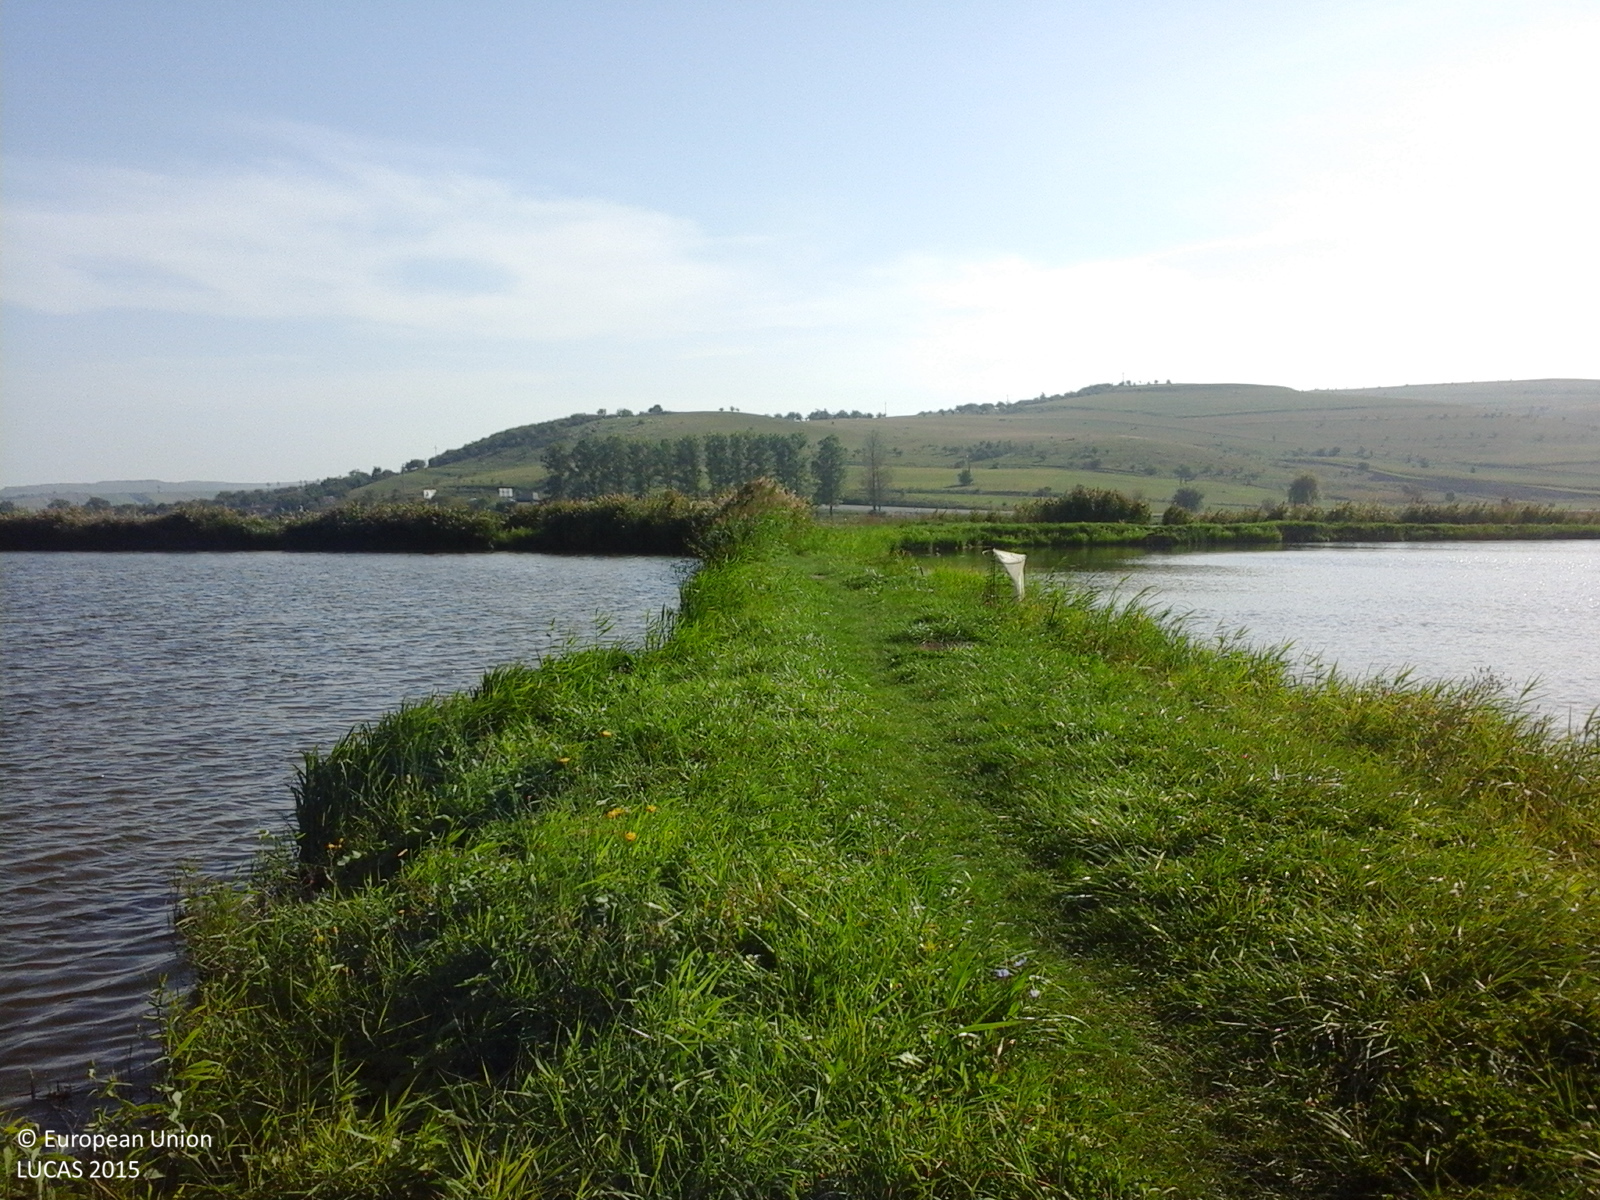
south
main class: Grassland
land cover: Grassland without tree/shrub cover
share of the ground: > 75 %
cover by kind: herbaceous plants 100 %
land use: Amenities, museums, leisure
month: September
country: RO
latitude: 46.6546
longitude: 23.6749
